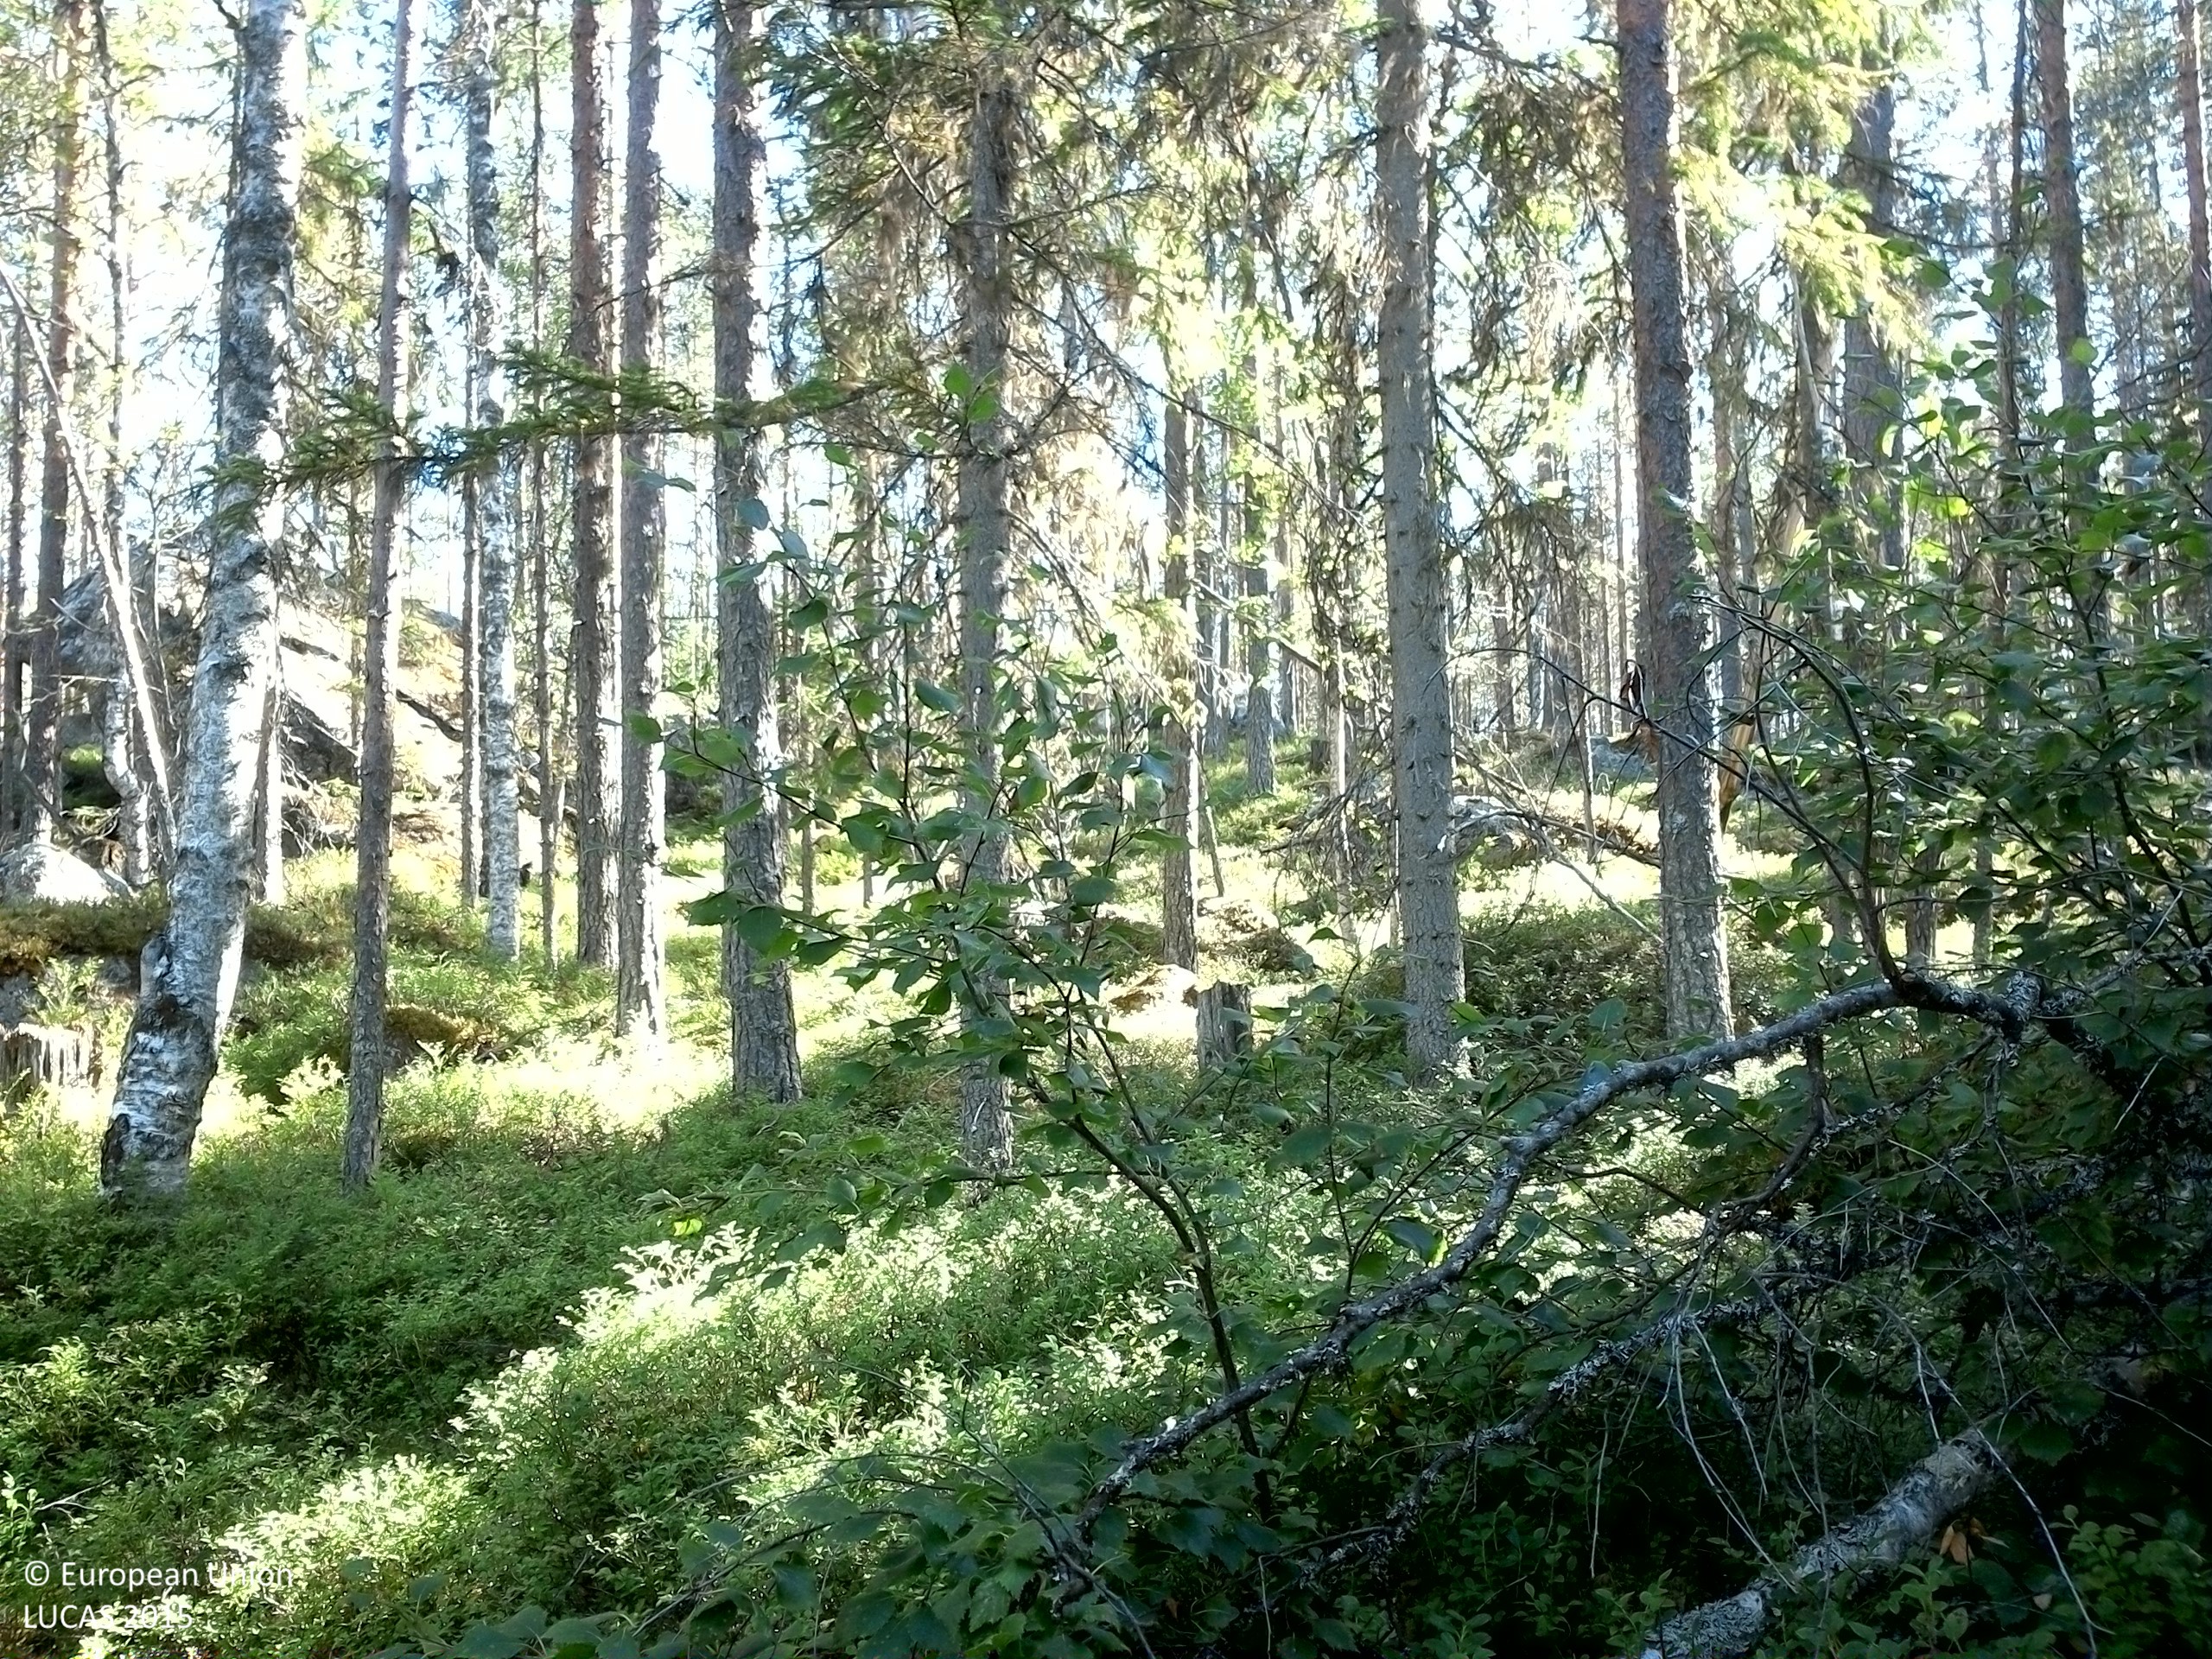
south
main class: Woodland
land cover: Pine dominated coniferous woodland
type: boreal forest
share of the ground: 50 - 75 %
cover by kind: coniferous forest trees 60 %, shrubs 30 %, broadleaved forest trees 10 %
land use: Forestry
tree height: > 5 m
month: August
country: SE
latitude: 63.7198
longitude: 17.7260
